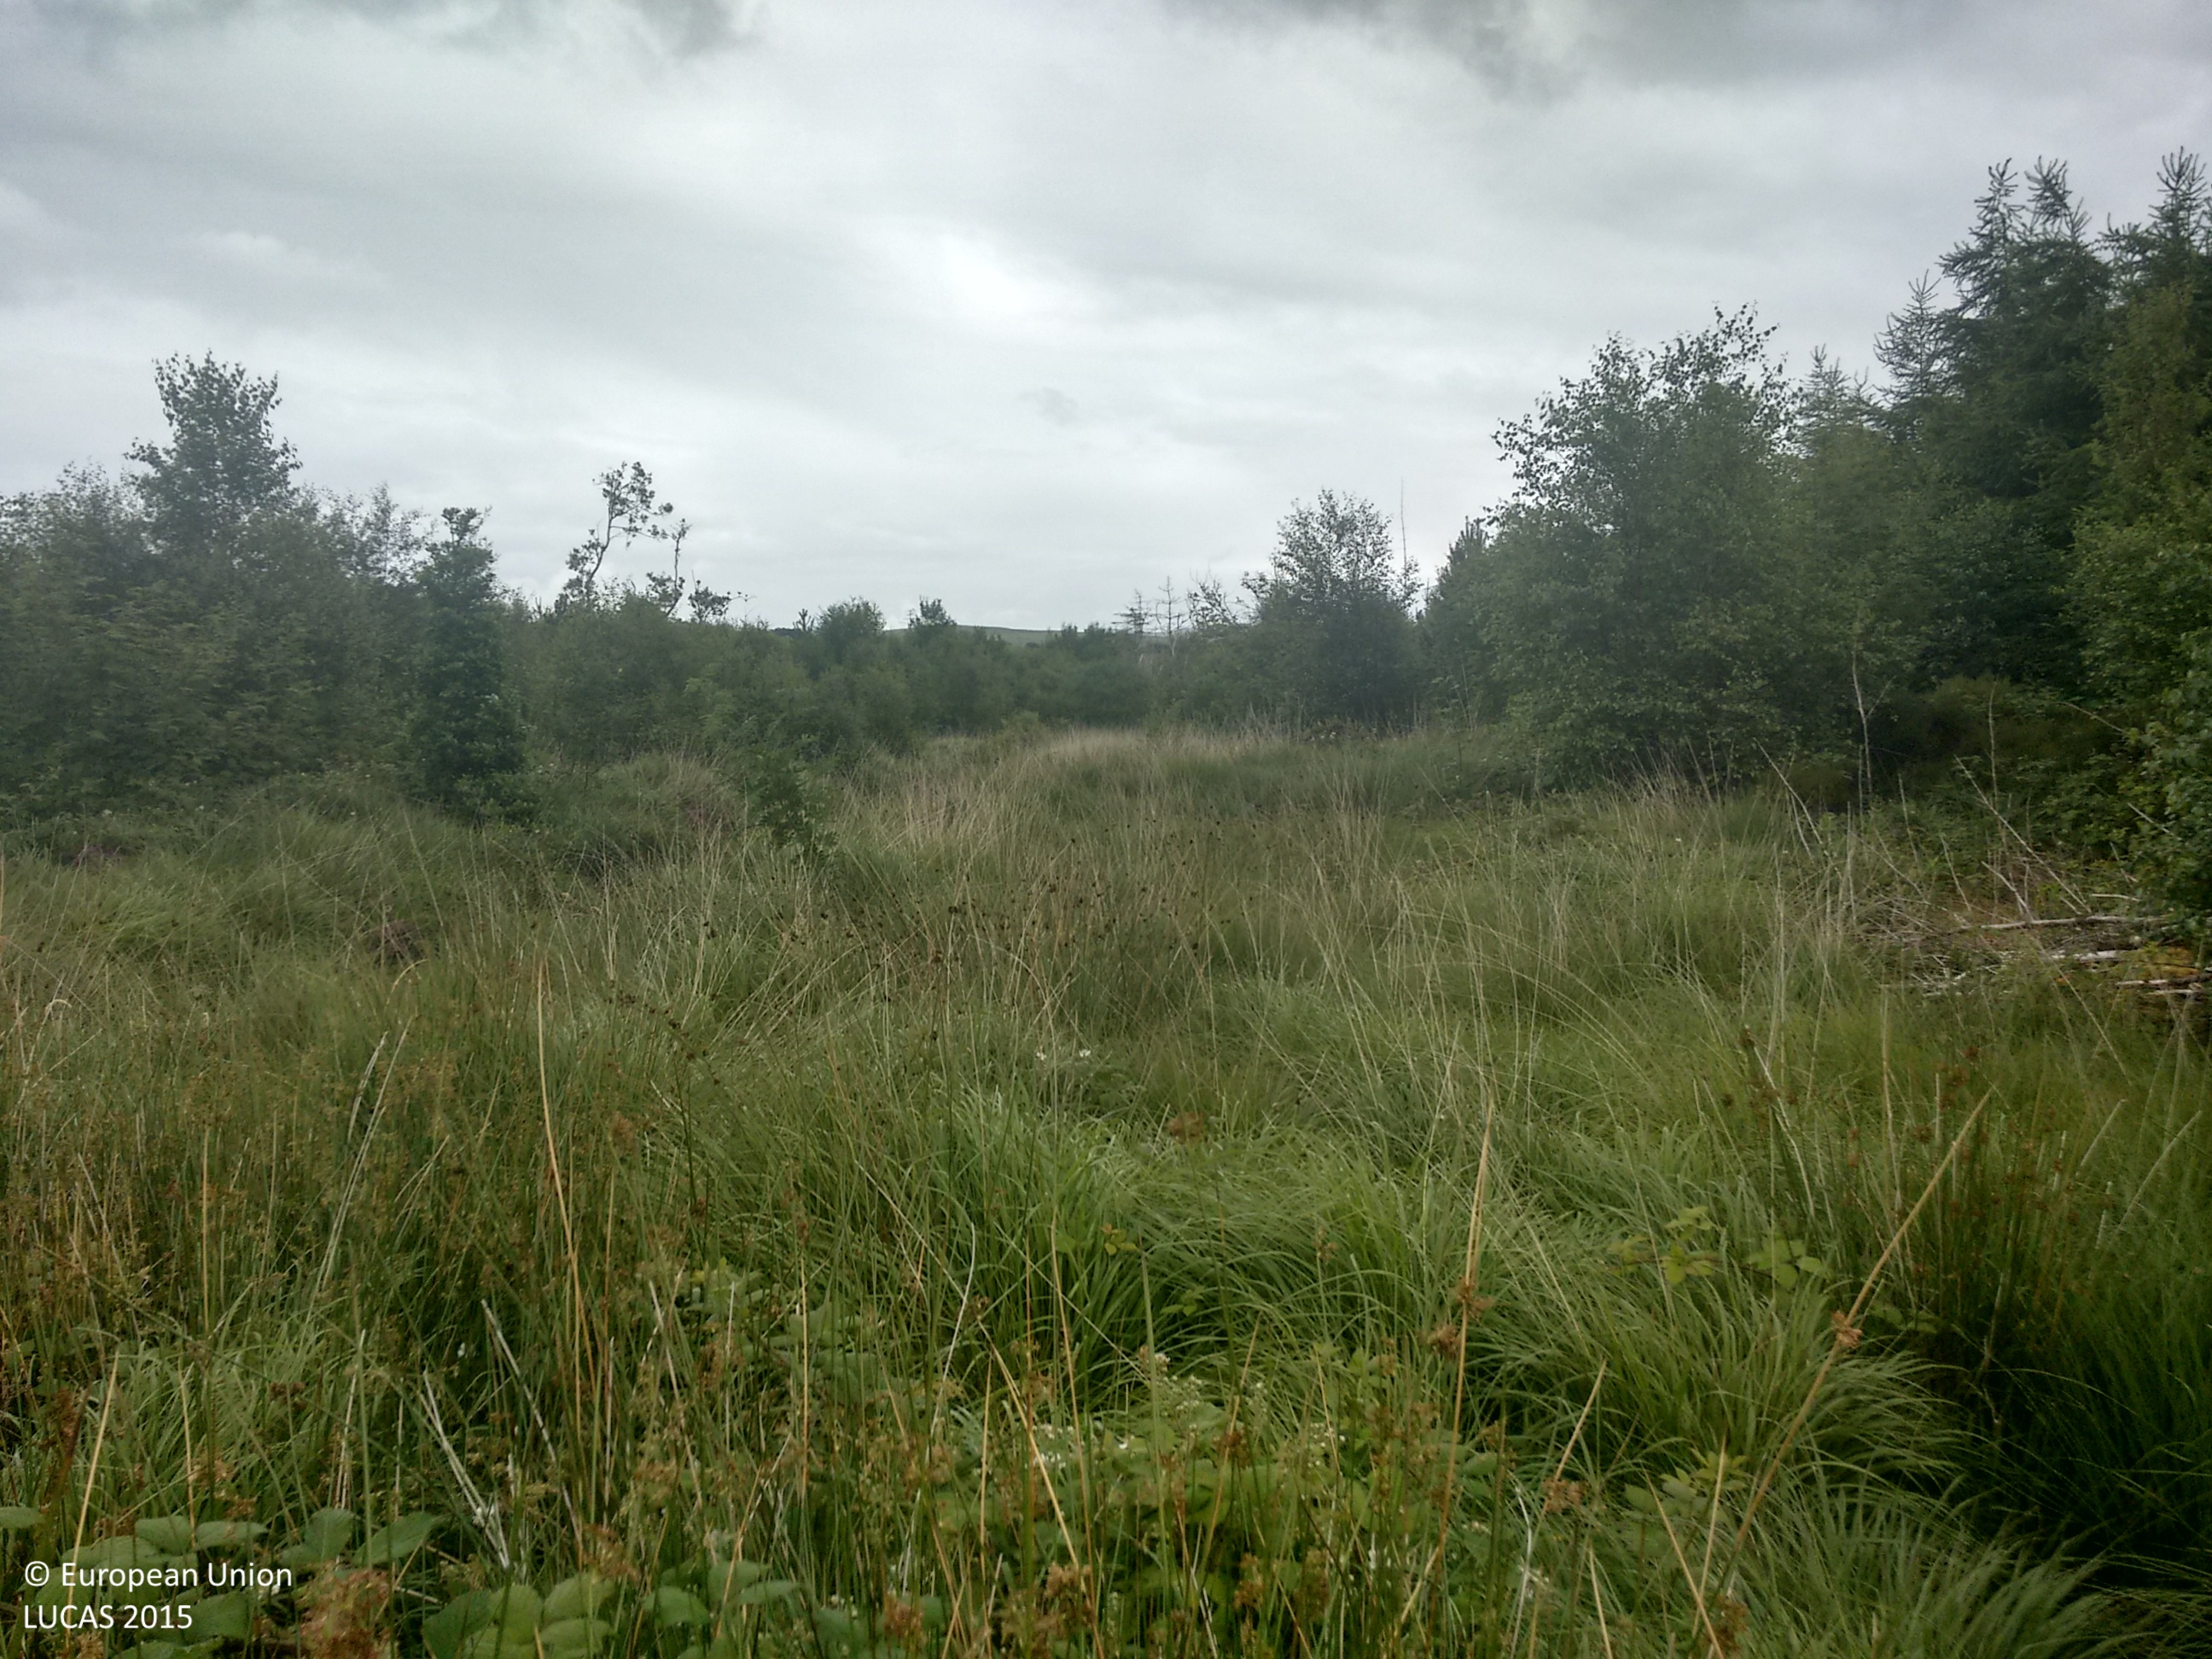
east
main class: Woodland
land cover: Other mixed woodland
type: exotic forest
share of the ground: > 75 %
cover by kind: coniferous forest trees 70 %, broadleaved forest trees 30 %
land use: Forestry
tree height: < 5 m
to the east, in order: Other mixed woodland; Broadleaved woodland; Tracks; Broadleaved woodland; Other mixed woodland
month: July
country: IE
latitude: 53.7299
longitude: -9.5607
